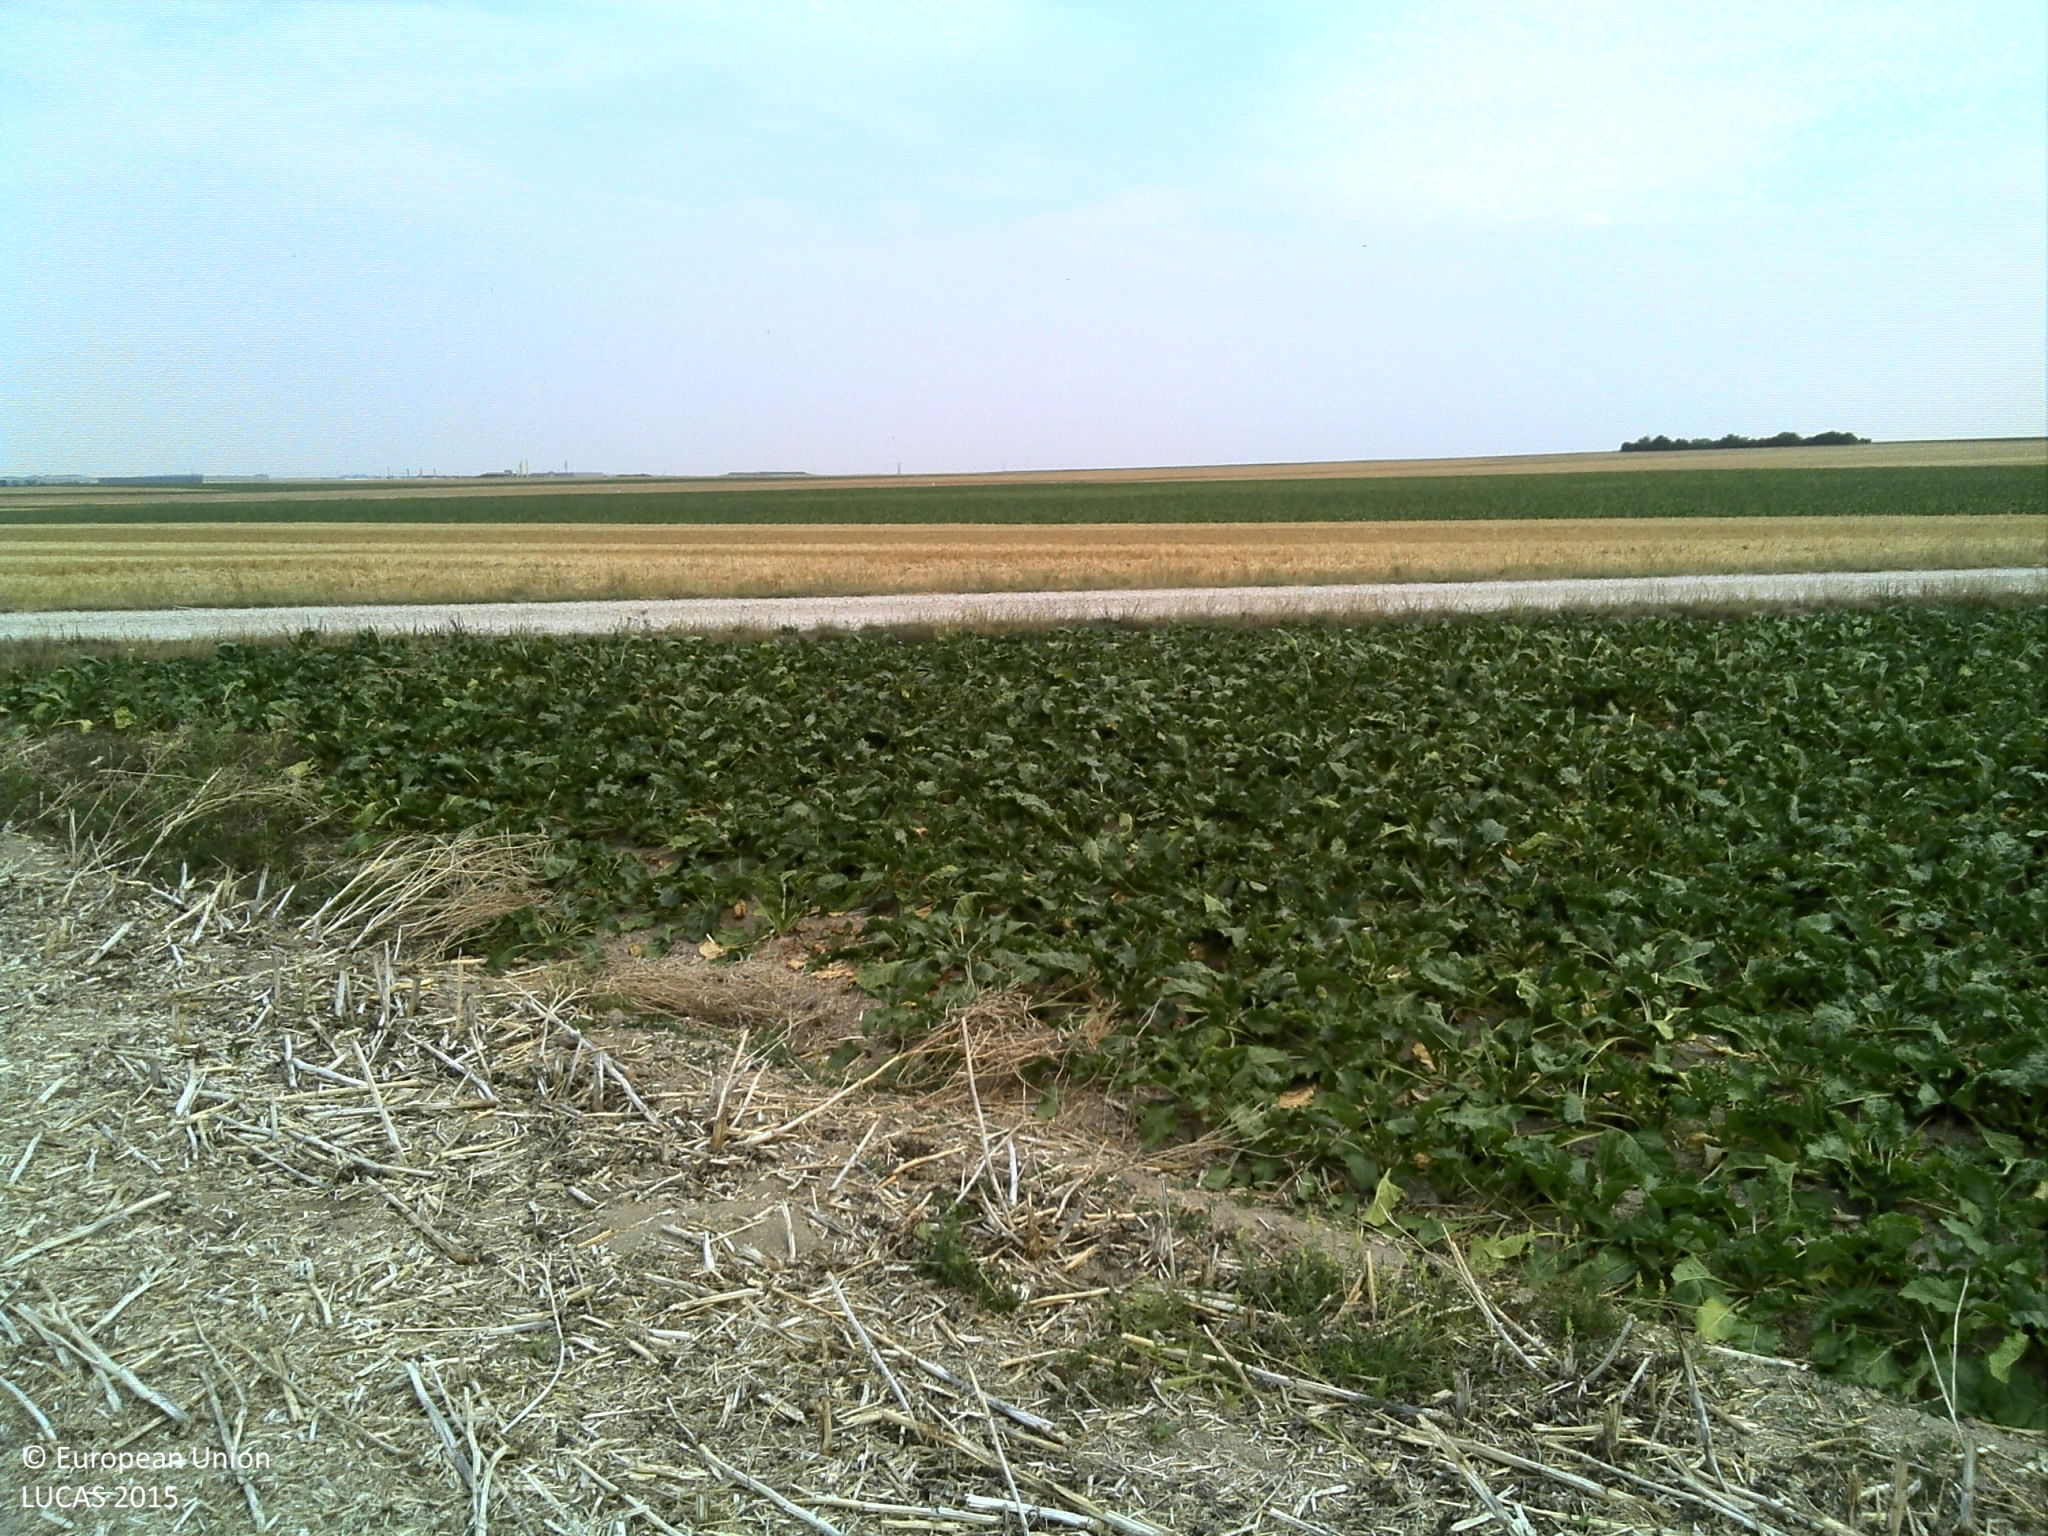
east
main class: Cropland
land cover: Rape and turnip rape
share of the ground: > 75 %
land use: Agriculture (excluding fallow land and kitchen gardens)
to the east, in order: Rape and turnip rape; Grass margins; Tracks; Grass margins; Barley; Sugar beet
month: August
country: FR
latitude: 48.9750
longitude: 4.2442
